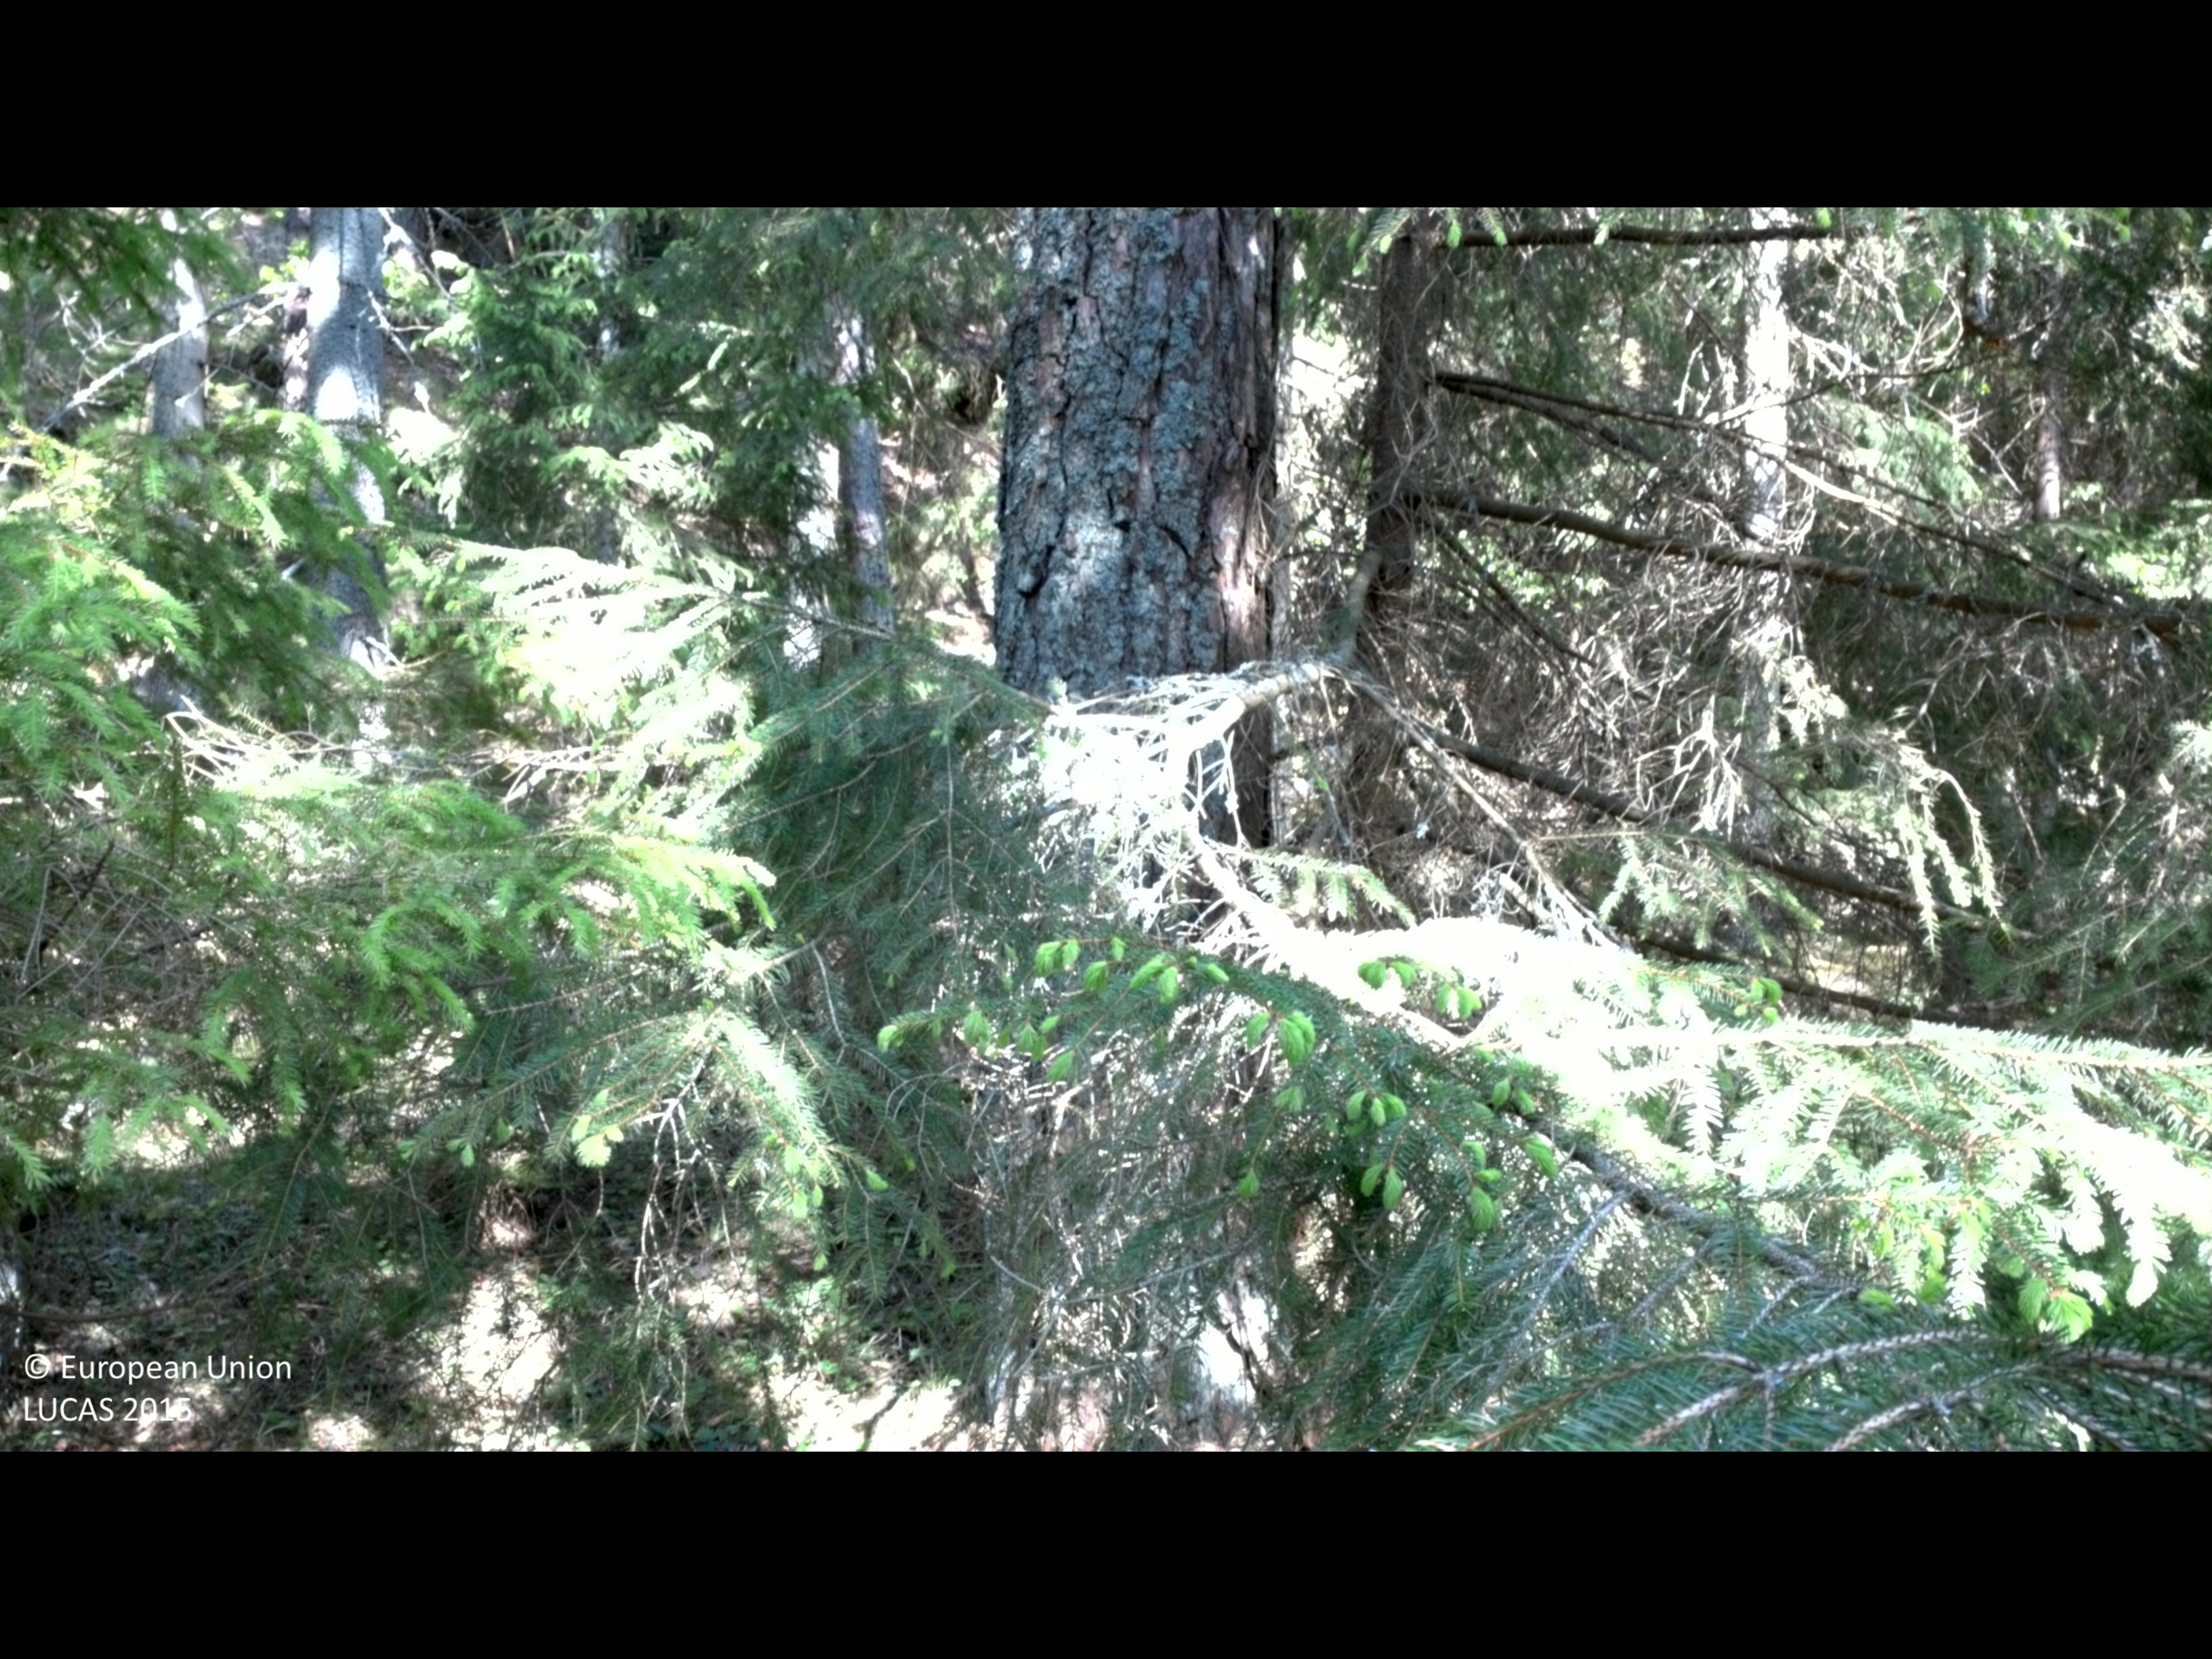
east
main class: Woodland
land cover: Spruce dominated coniferous woodland
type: boreal forest
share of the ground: 50 - 75 %
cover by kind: coniferous forest trees 60 %, herbaceous plants 30 %, shrubs 5 %, lichens and mosses 5 %
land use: Forestry
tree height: > 5 m
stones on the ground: < 10 %
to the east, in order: Spruce dominated coniferous woodland; Fences; Pine dominated mixed woodland; Tracks; Spruce dominated coniferous woodland; Spontaneously vegetated surfaces; Broadleaved woodland; Spontaneously vegetated surfaces
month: June
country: SE
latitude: 57.8218
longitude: 16.2436
